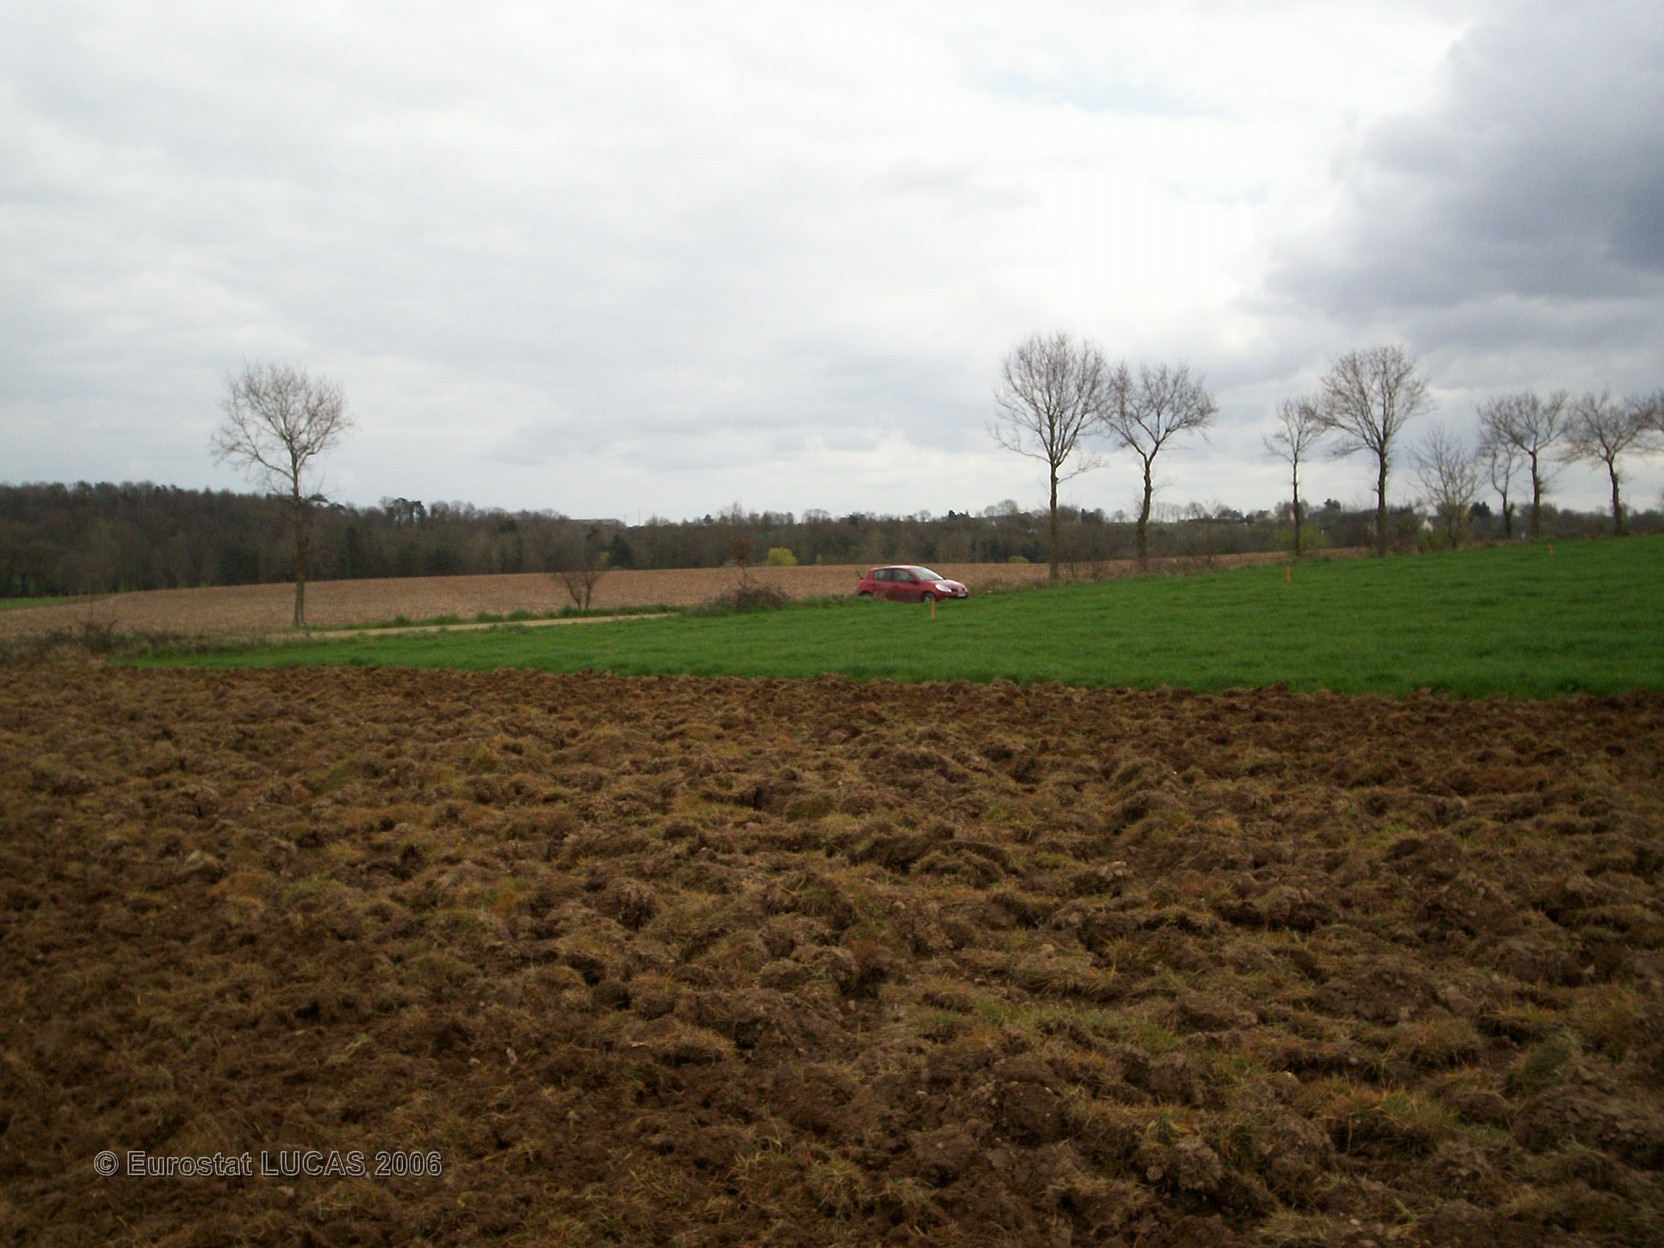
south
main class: Cropland
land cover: Dry pulses
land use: Agriculture (excluding fallow land and kitchen gardens)
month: May
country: FR
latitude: 48.0943
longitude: -2.9438
